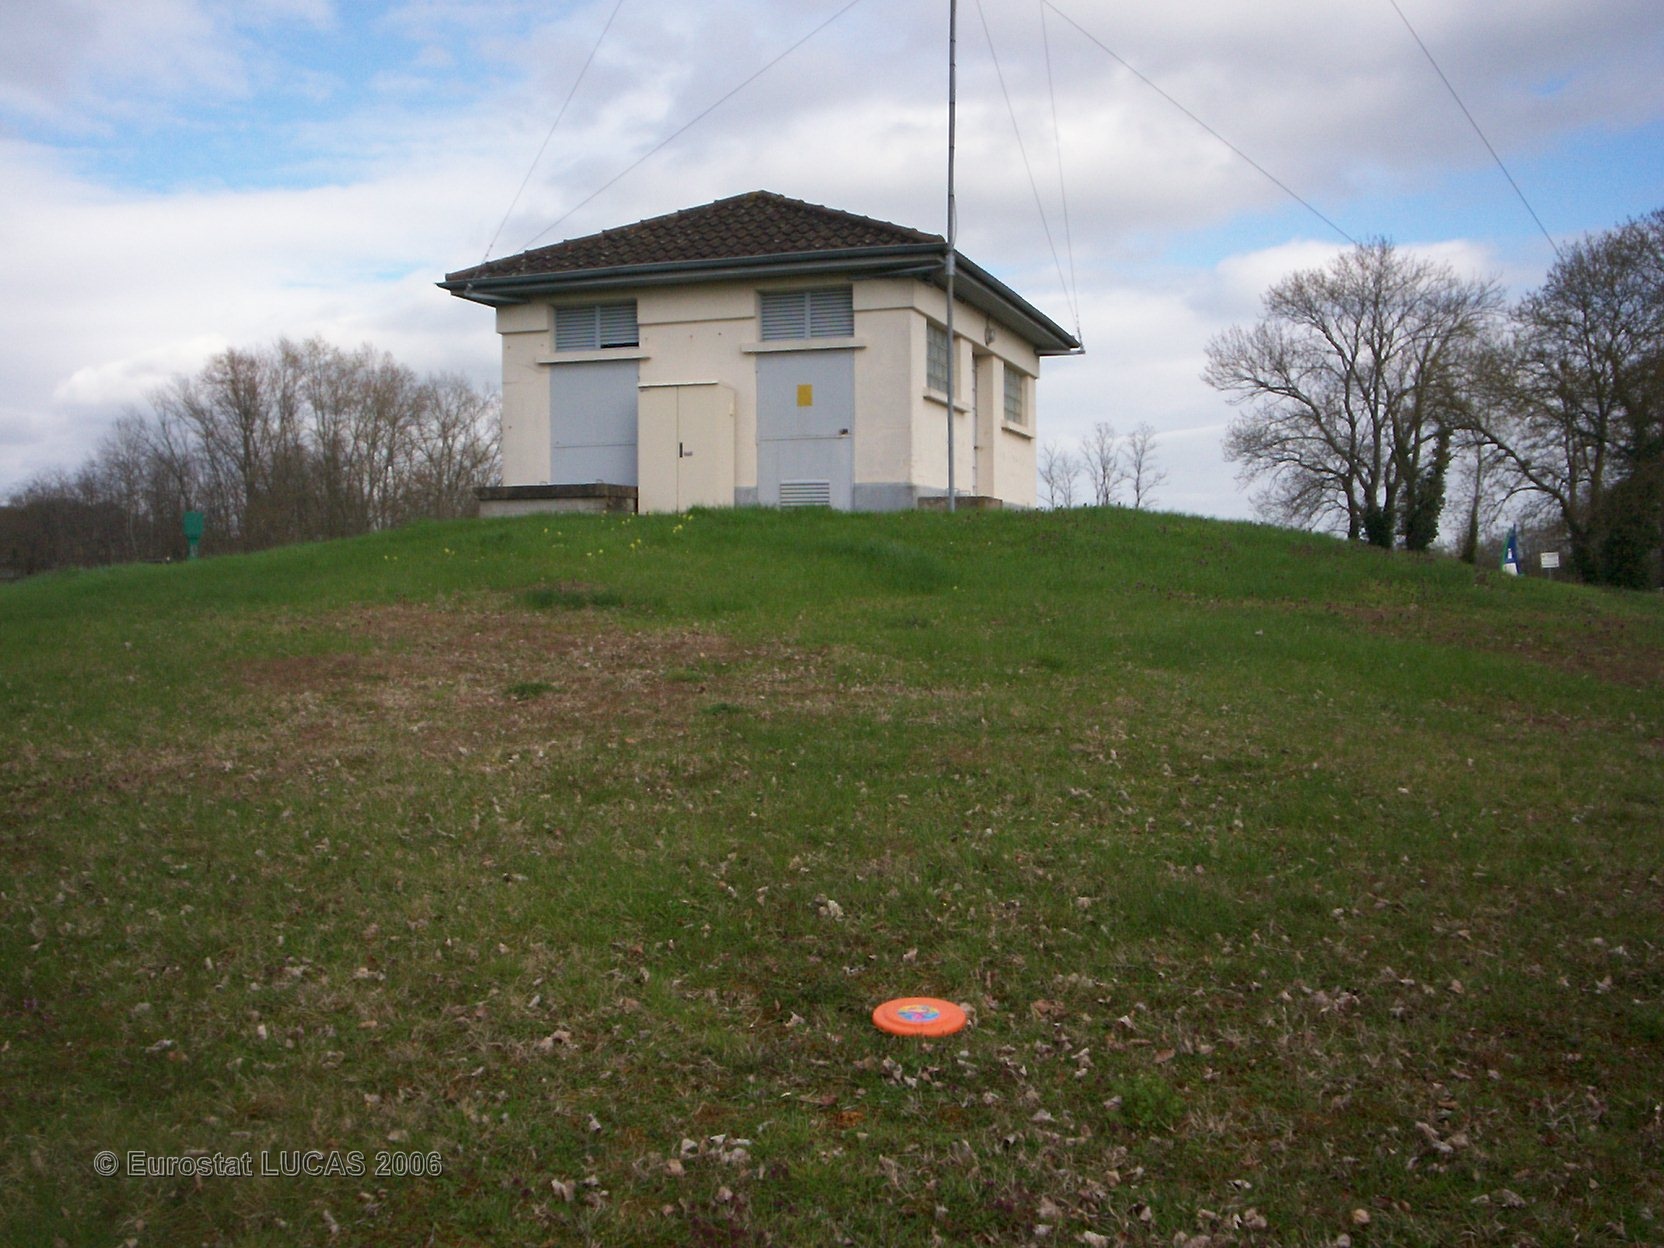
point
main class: Grassland
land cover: Grassland without tree/shrub cover
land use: Community services
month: April
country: FR
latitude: 46.7573
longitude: 3.0447
